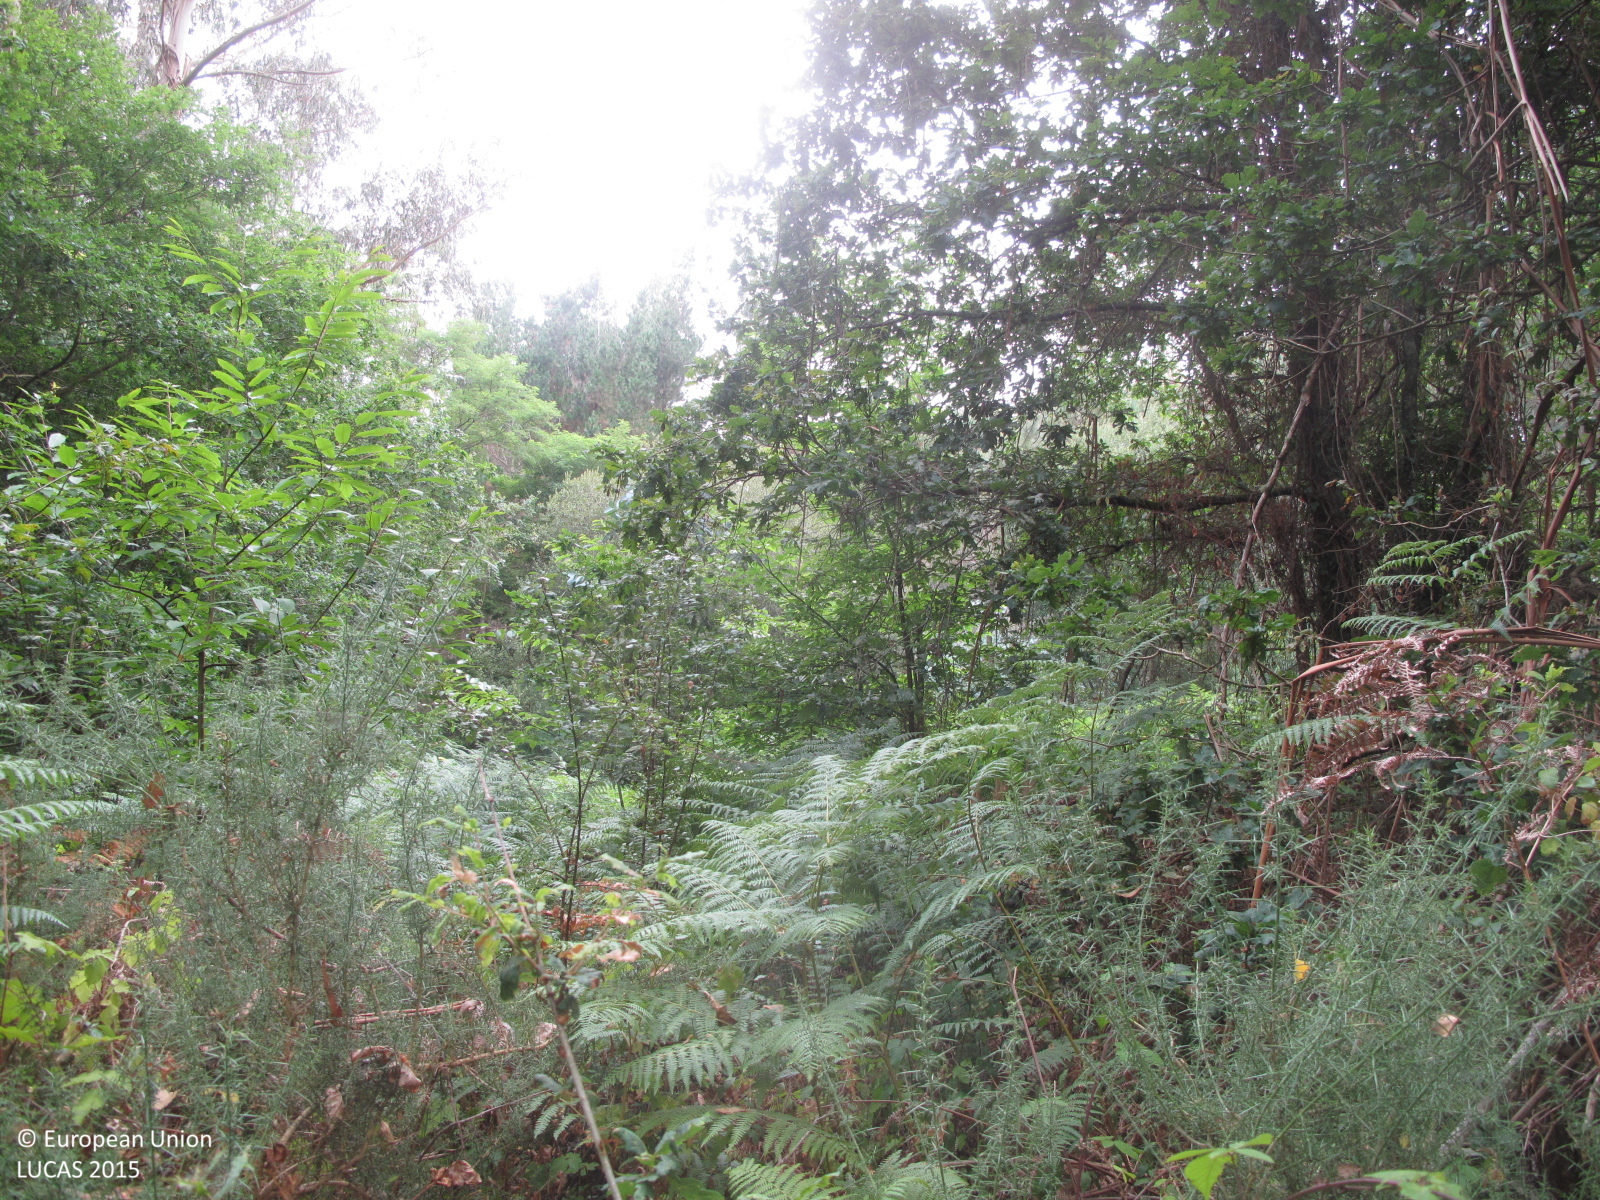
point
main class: Woodland
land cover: Broadleaved woodland
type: acidophilous oak and oak-birch forest
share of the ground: 50 - 75 %
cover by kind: broadleaved forest trees 60 %, shrubs 20 %, herbaceous plants 20 %
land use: Forestry
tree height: > 5 m
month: July
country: ES
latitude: 43.2559
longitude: -8.1178
